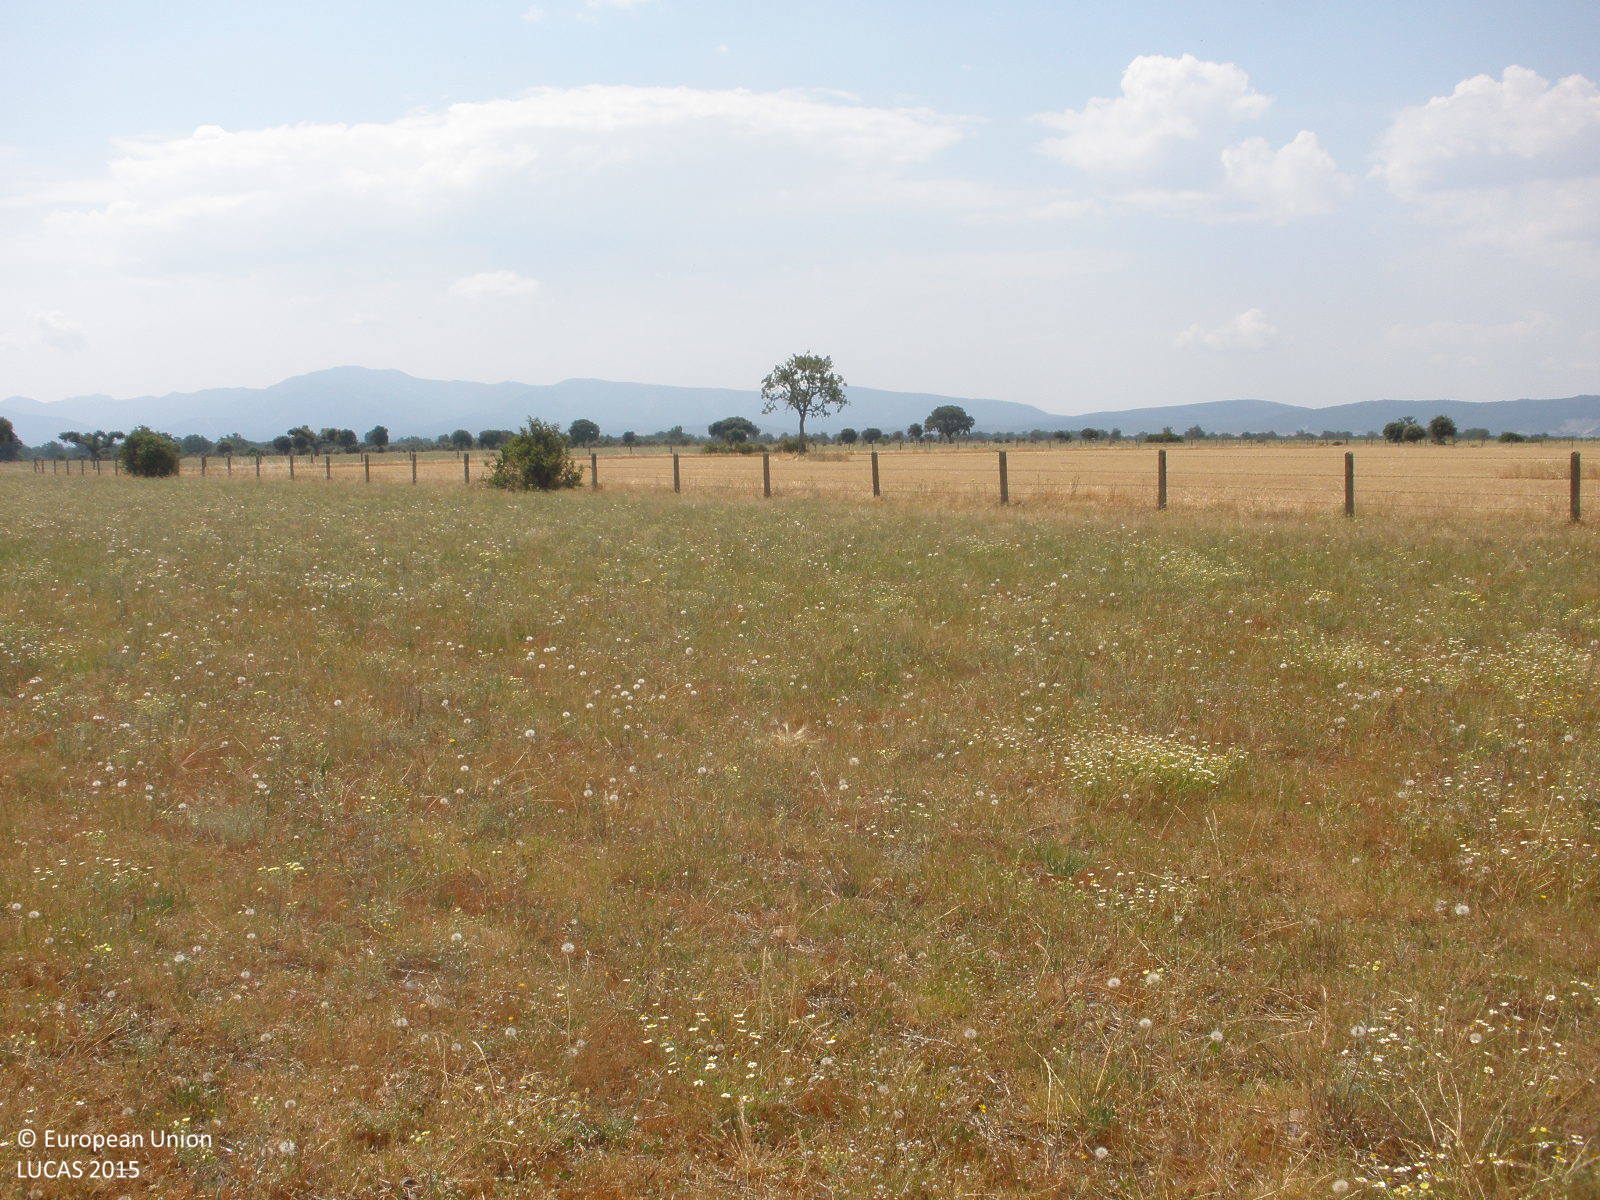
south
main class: Grassland
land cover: Grassland without tree/shrub cover
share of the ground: > 75 %
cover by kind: herbaceous plants 100 %
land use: Agriculture (excluding fallow land and kitchen gardens)
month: June
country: ES
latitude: 40.6392
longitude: -6.3205
